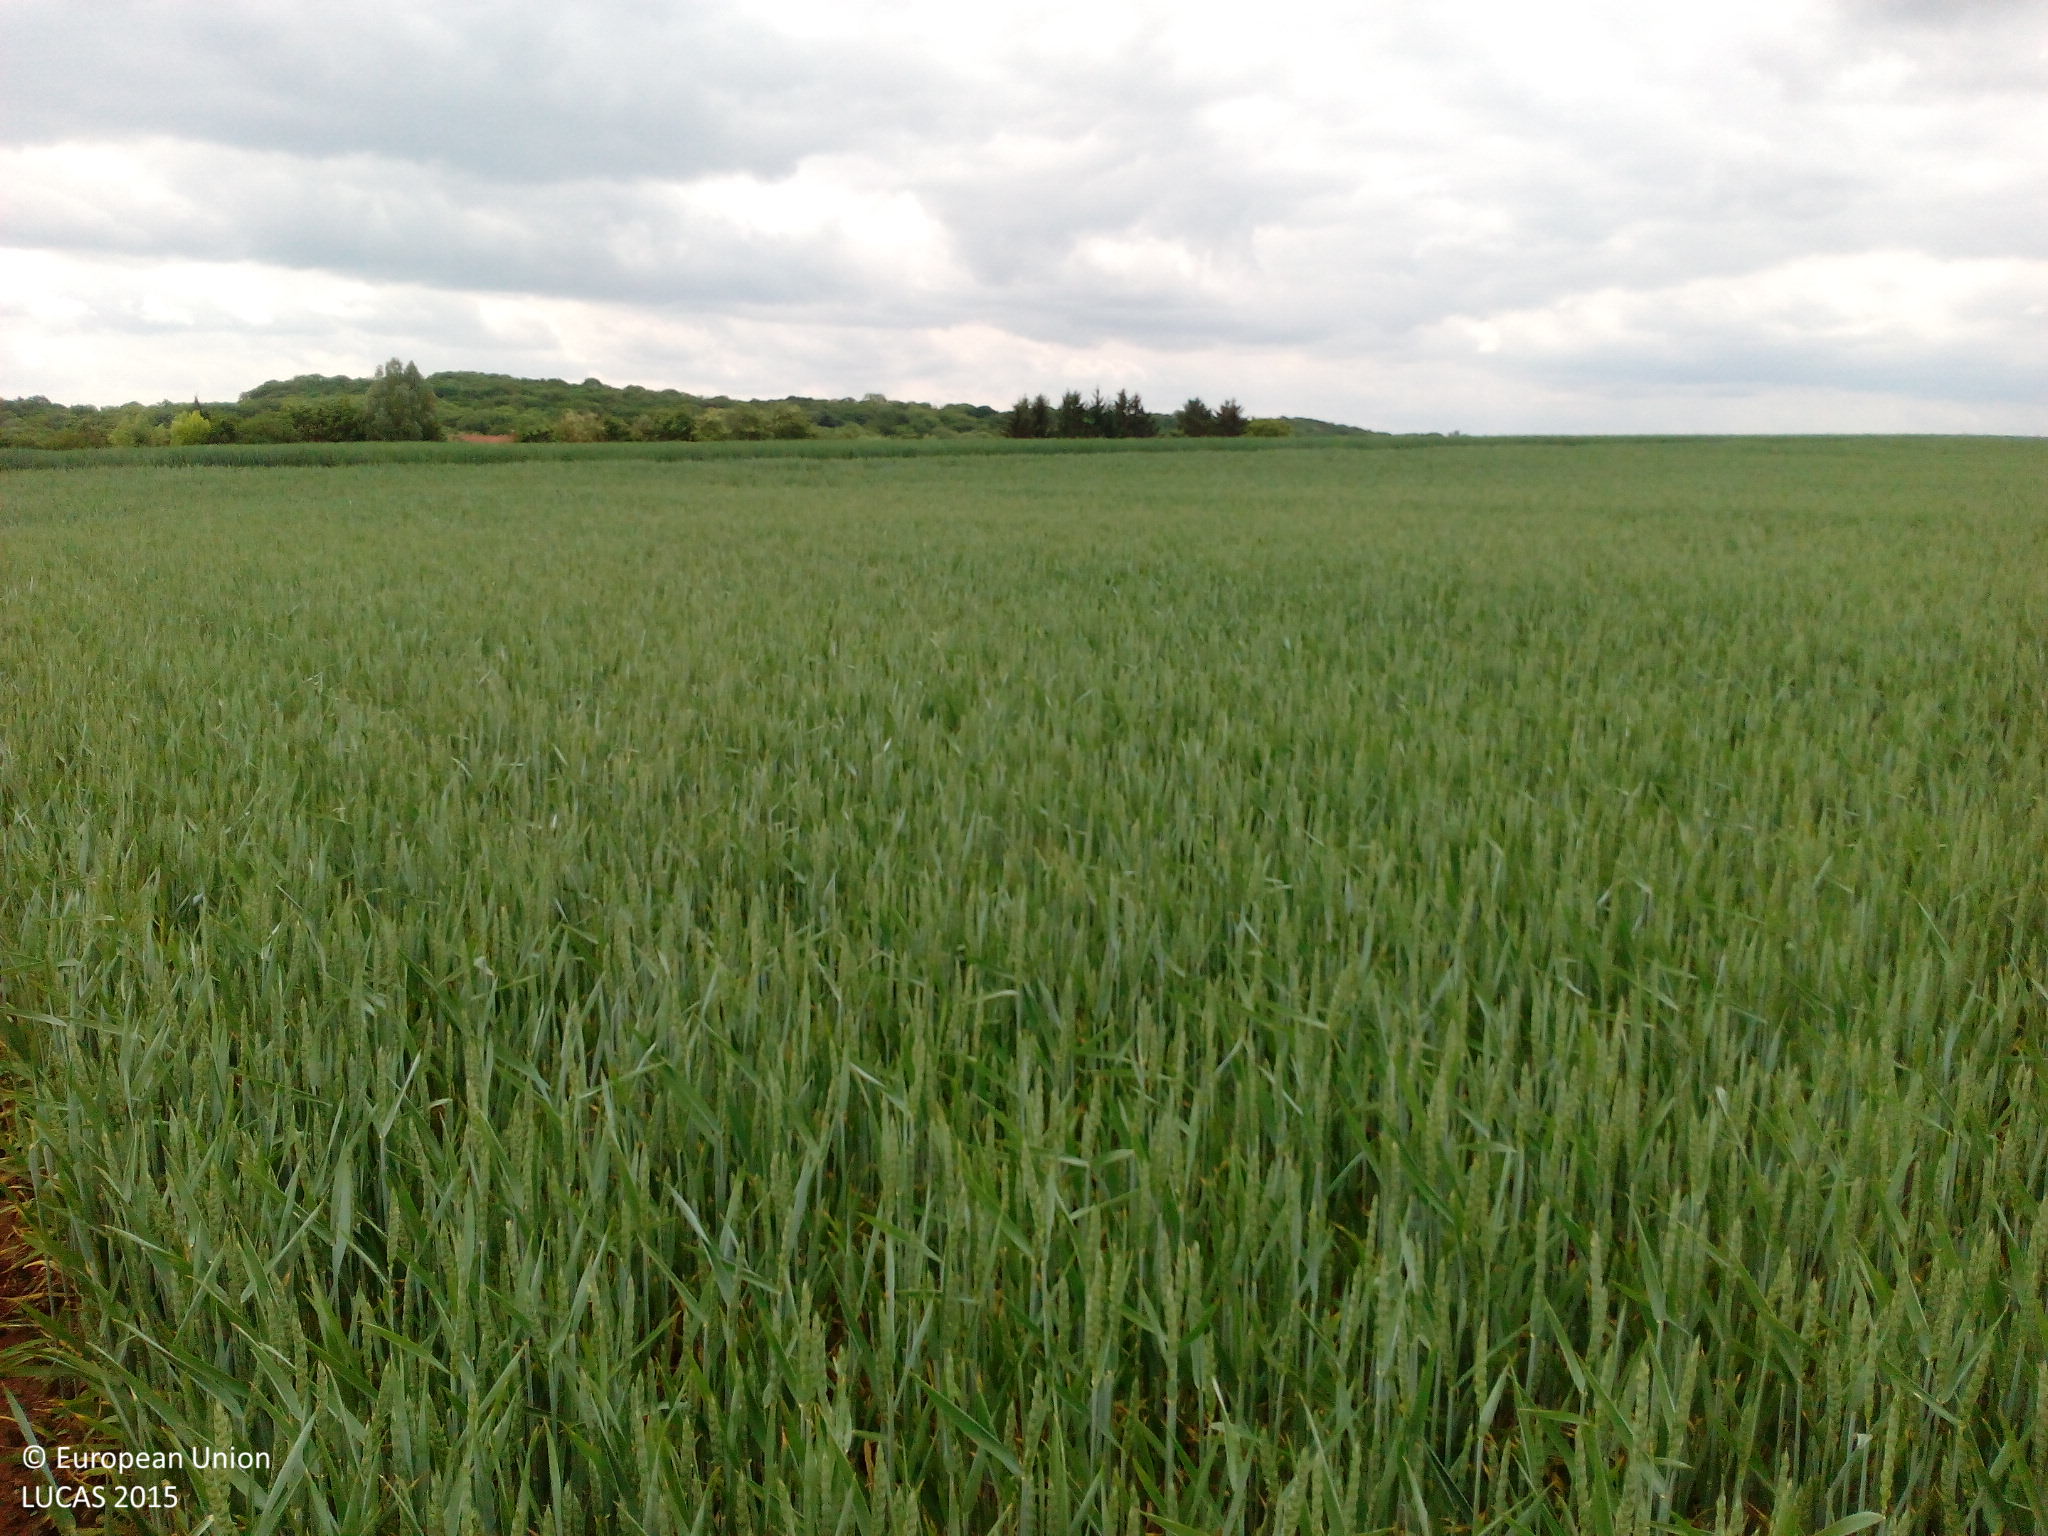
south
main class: Cropland
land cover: Common wheat
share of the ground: > 75 %
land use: Agriculture (excluding fallow land and kitchen gardens)
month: May
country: DE
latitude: 49.9155
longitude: 8.0368
